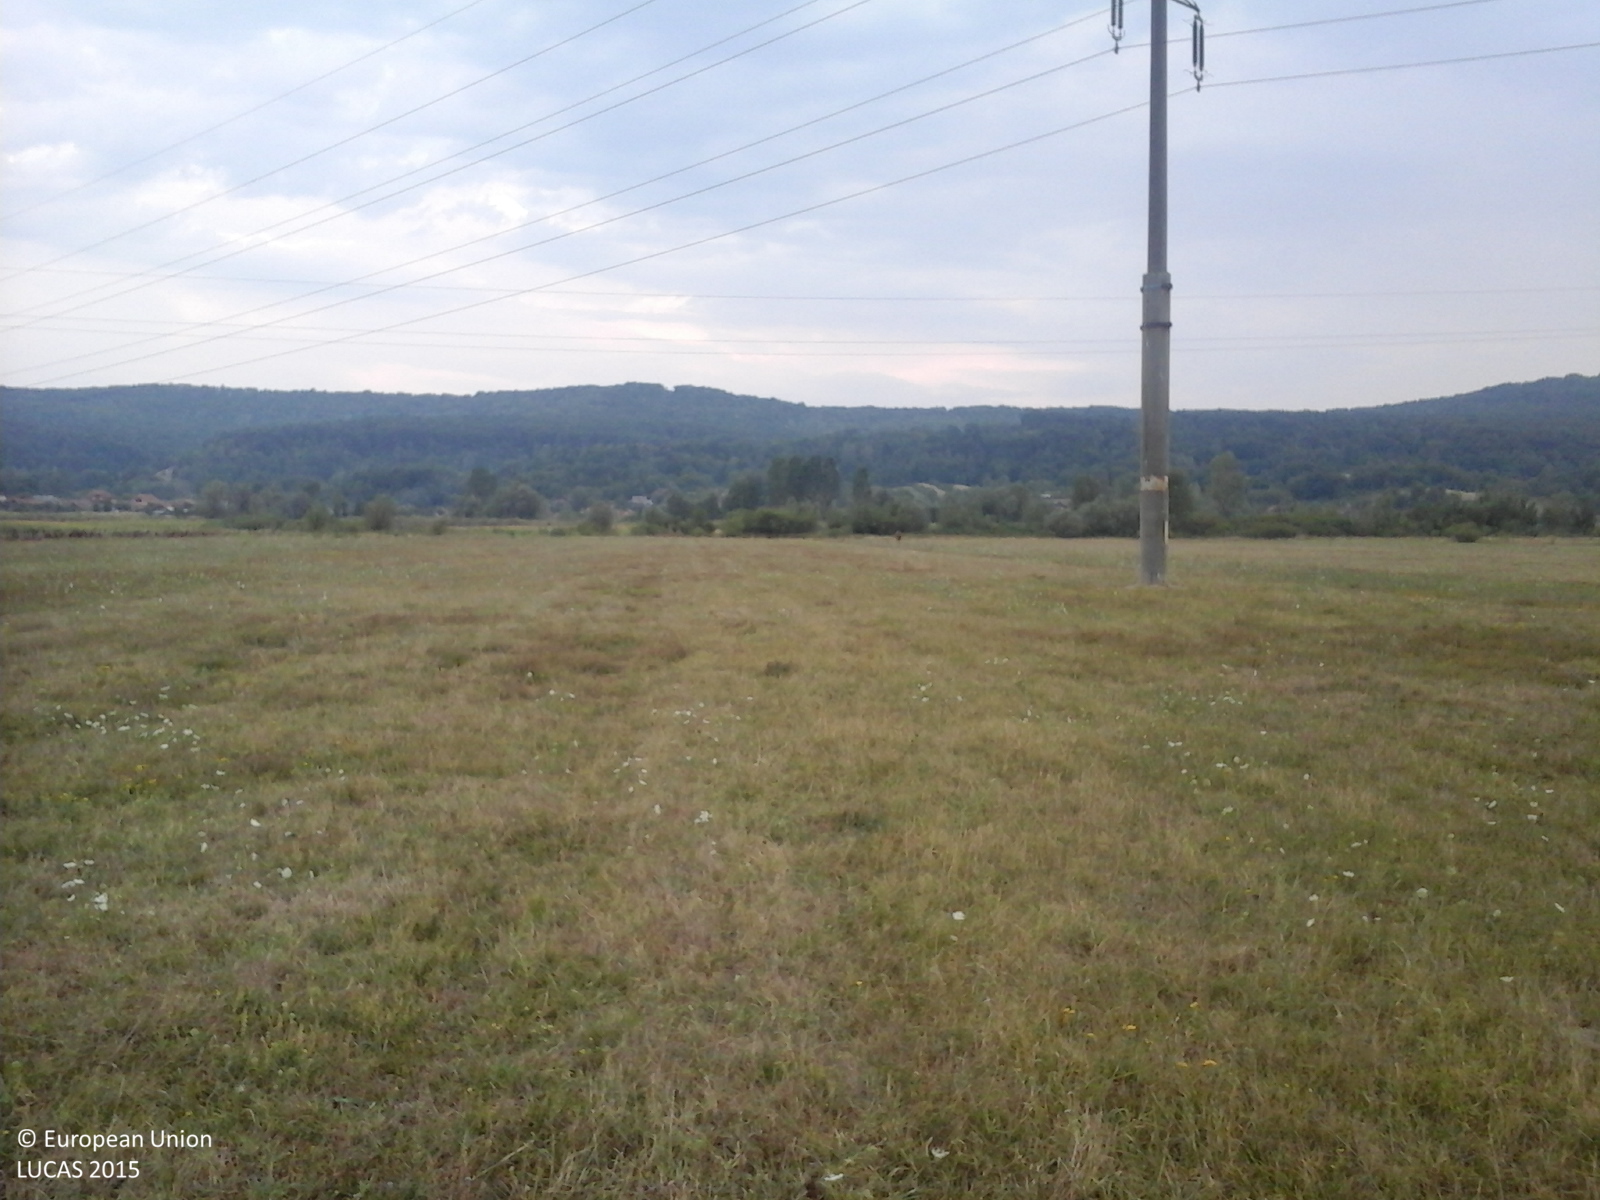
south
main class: Grassland
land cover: Grassland without tree/shrub cover
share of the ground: > 75 %
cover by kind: herbaceous plants 100 %
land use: Agriculture (excluding fallow land and kitchen gardens)
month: August
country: RO
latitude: 44.6927
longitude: 23.0320
